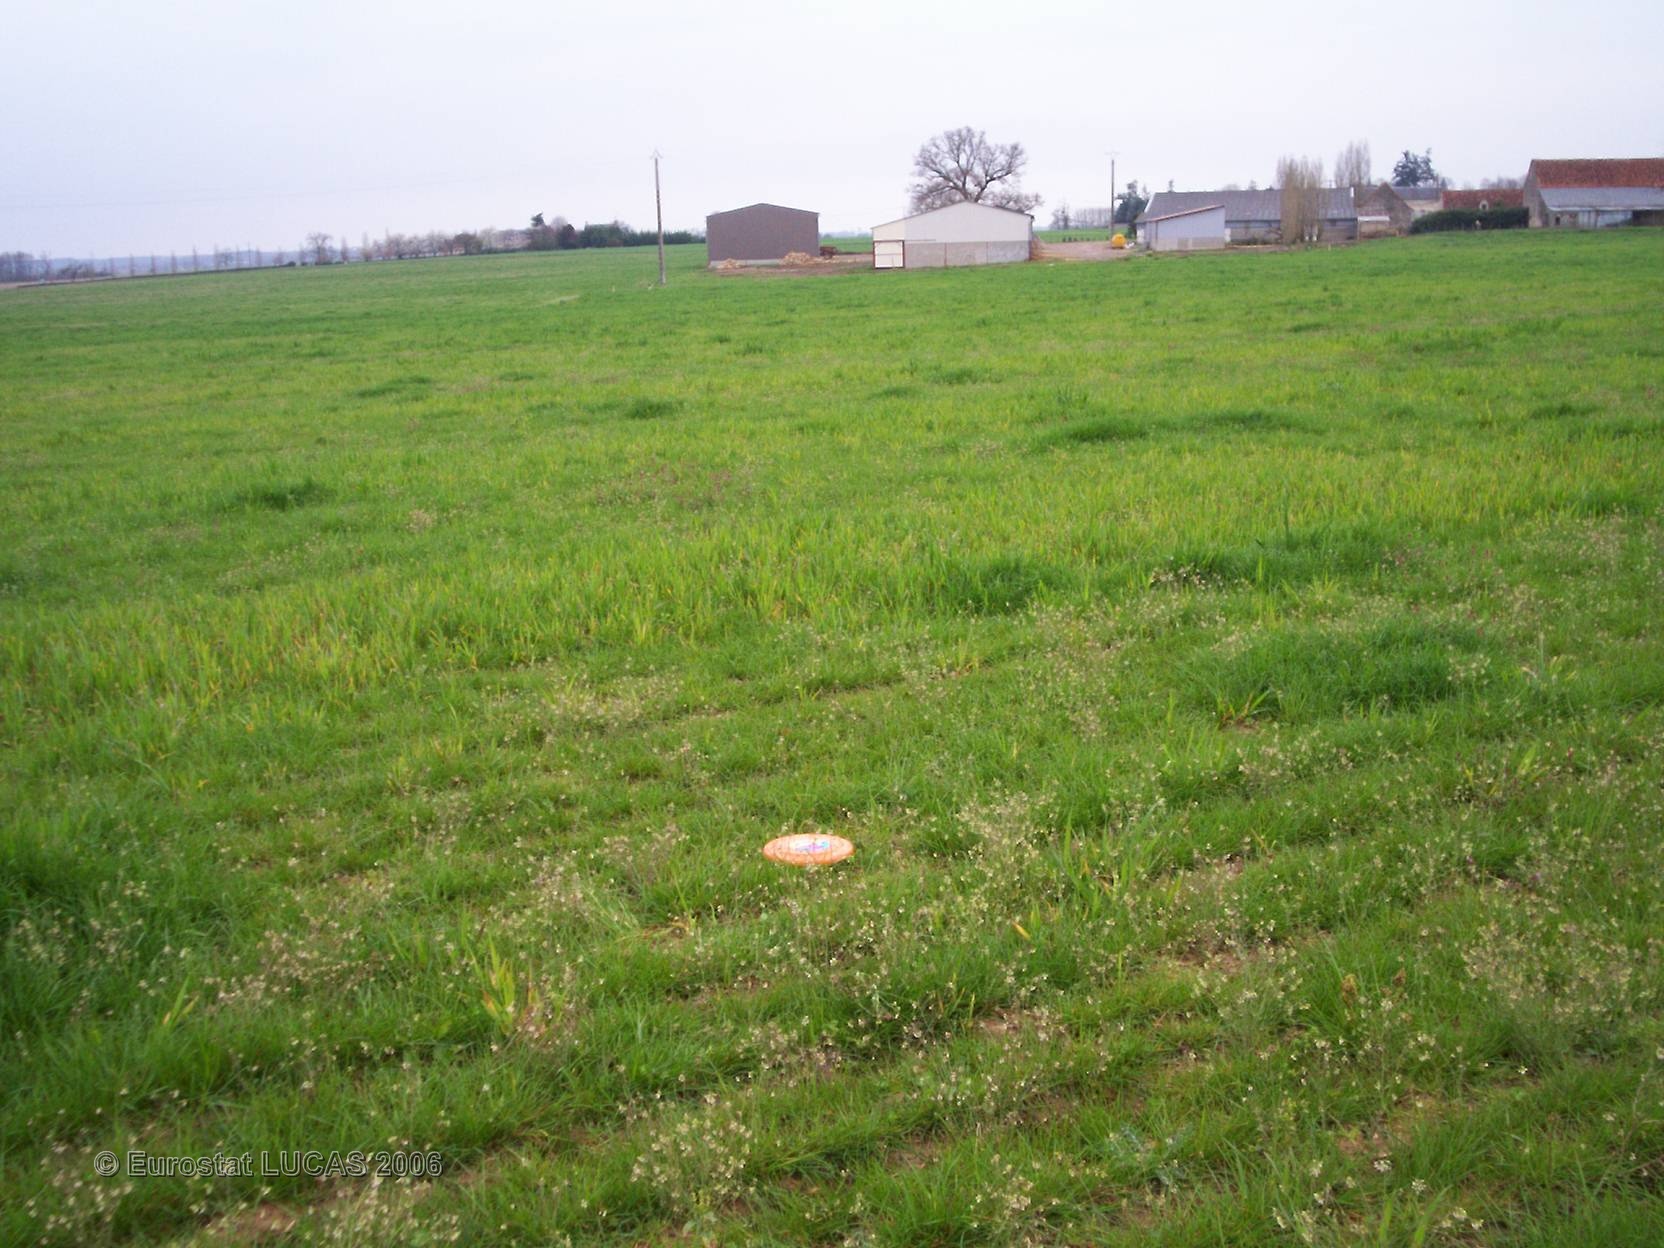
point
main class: Grassland
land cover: Grassland without tree/shrub cover
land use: Agriculture (excluding fallow land and kitchen gardens)
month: April
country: FR
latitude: 46.5731
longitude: 1.0487
